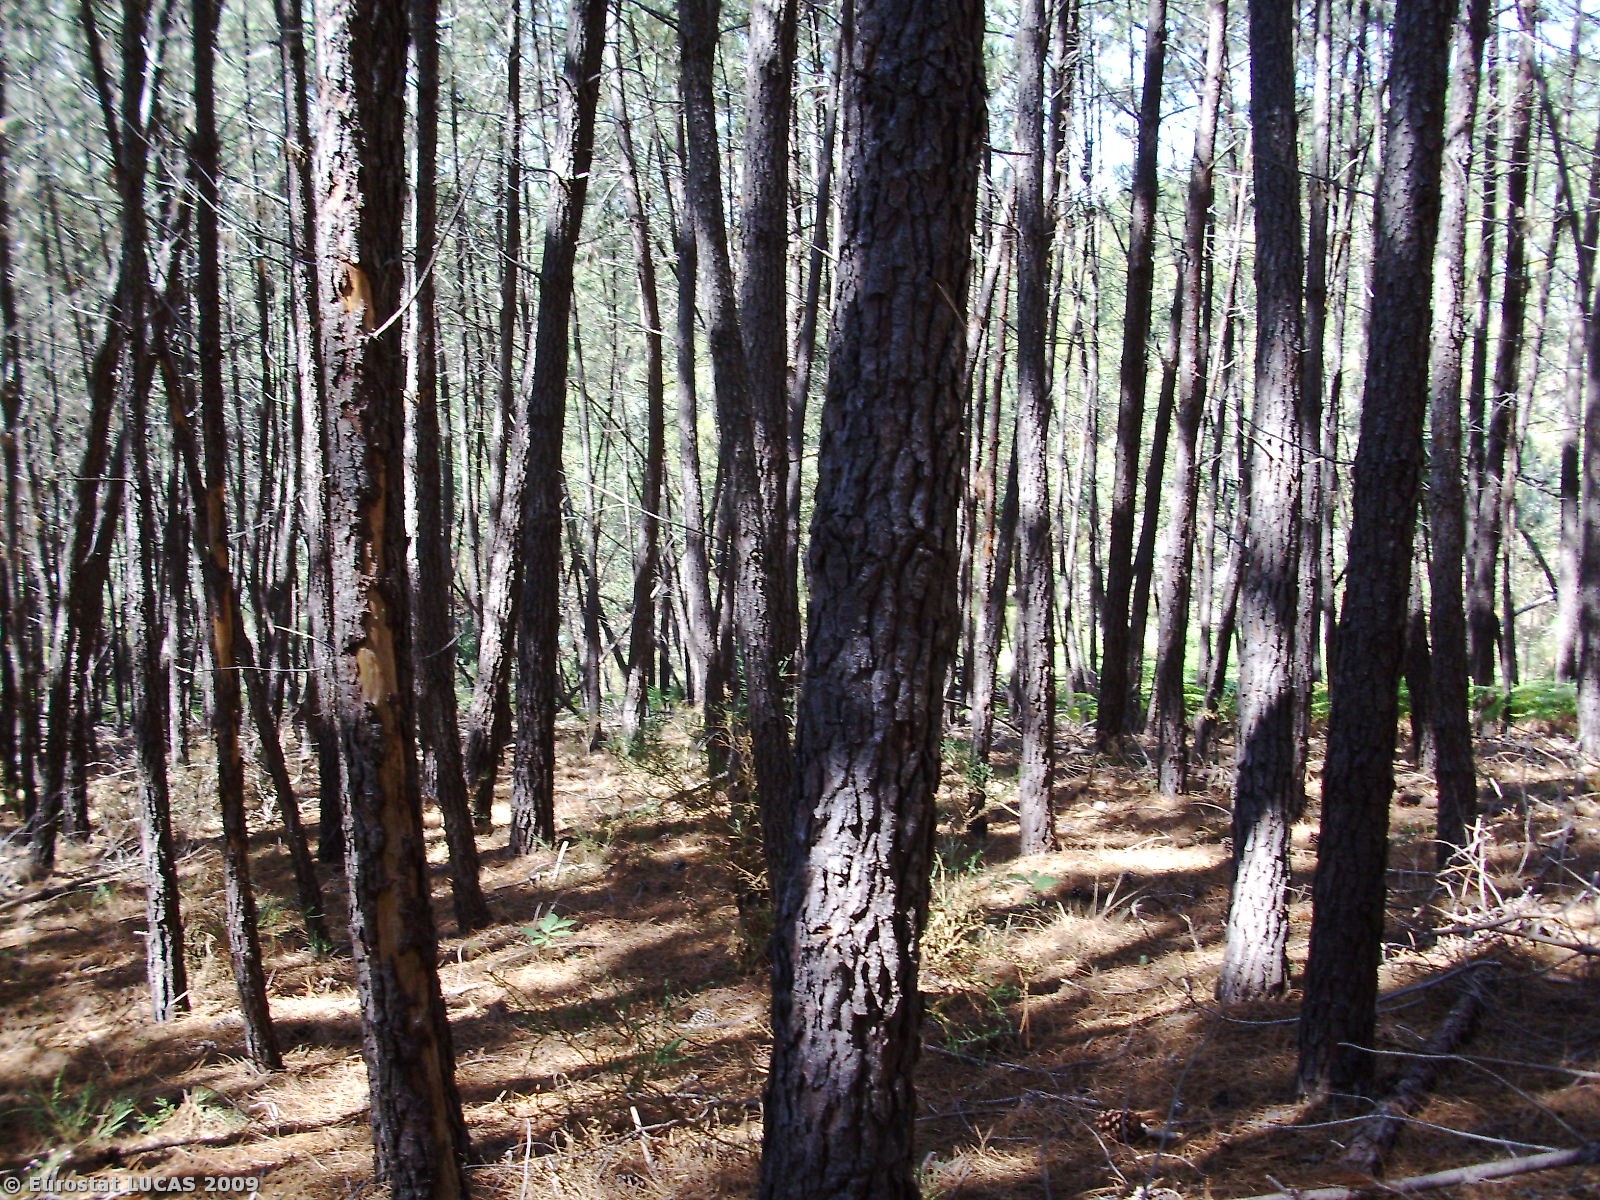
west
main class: Woodland
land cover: Coniferous woodland
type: coniferous forest of the mediterranean region
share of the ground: > 75 %
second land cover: Shrubland with sparse tree cover
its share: 10 - 25 %
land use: Forestry
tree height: > 5 m
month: August
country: PT
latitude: 39.9967
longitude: -8.1688
